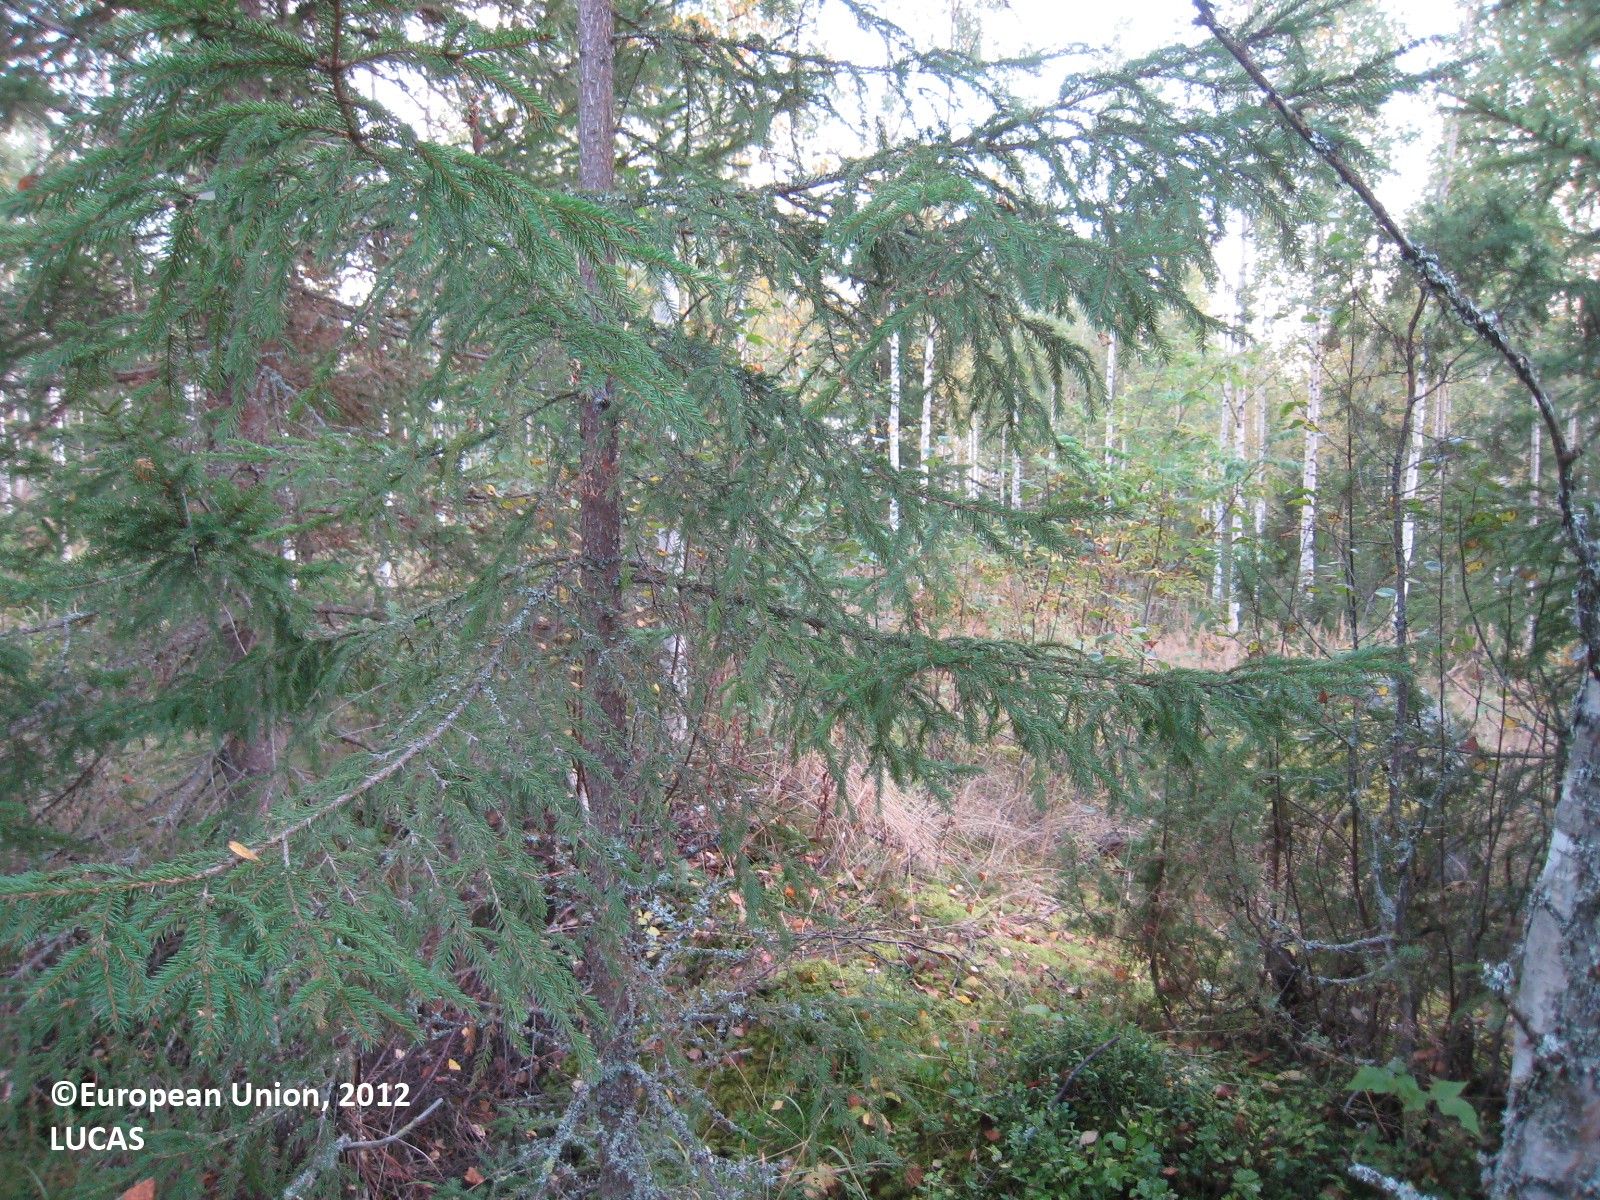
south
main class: Woodland
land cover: Spruce dominated mixed woodland
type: boreal forest
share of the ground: 50 - 75 %
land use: Forestry
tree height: > 5 m
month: September
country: FI
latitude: 62.6403
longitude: 26.4600
